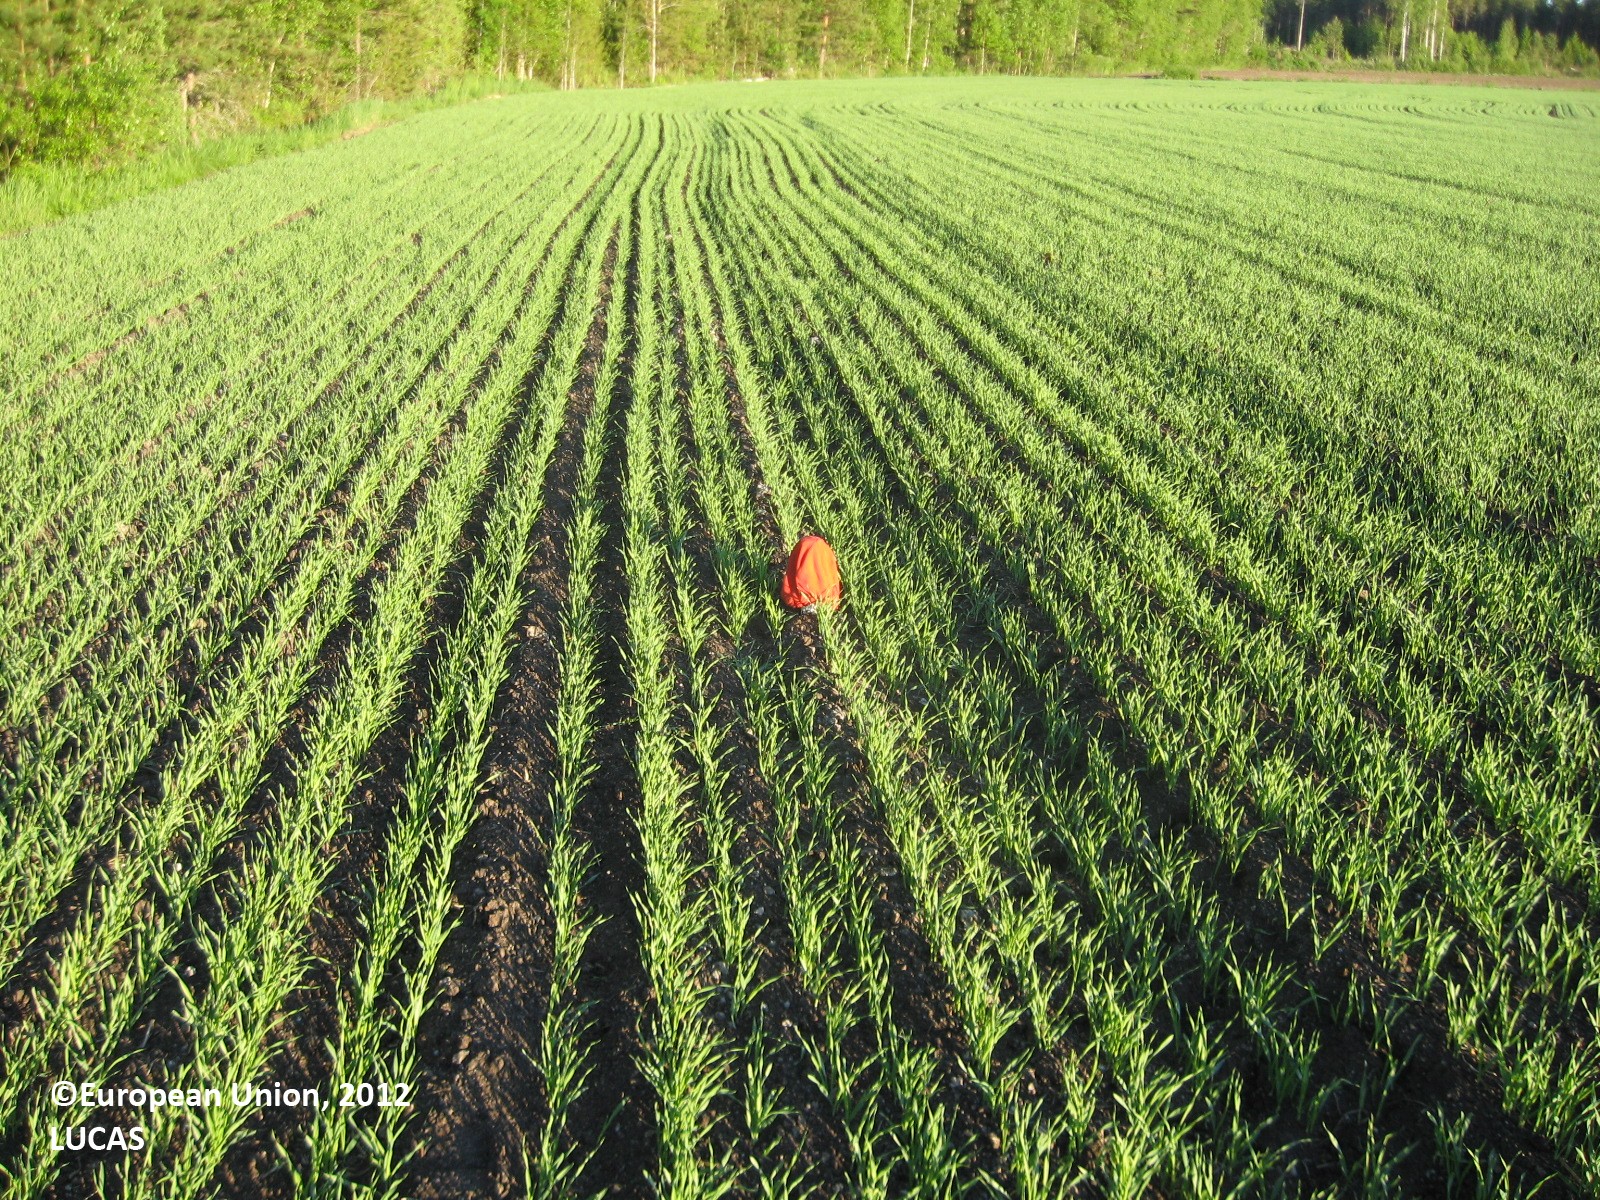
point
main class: Cropland
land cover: Barley
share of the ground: 50 - 75 %
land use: Agriculture (excluding fallow land and kitchen gardens)
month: June
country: FI
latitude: 63.2379
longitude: 22.7731
